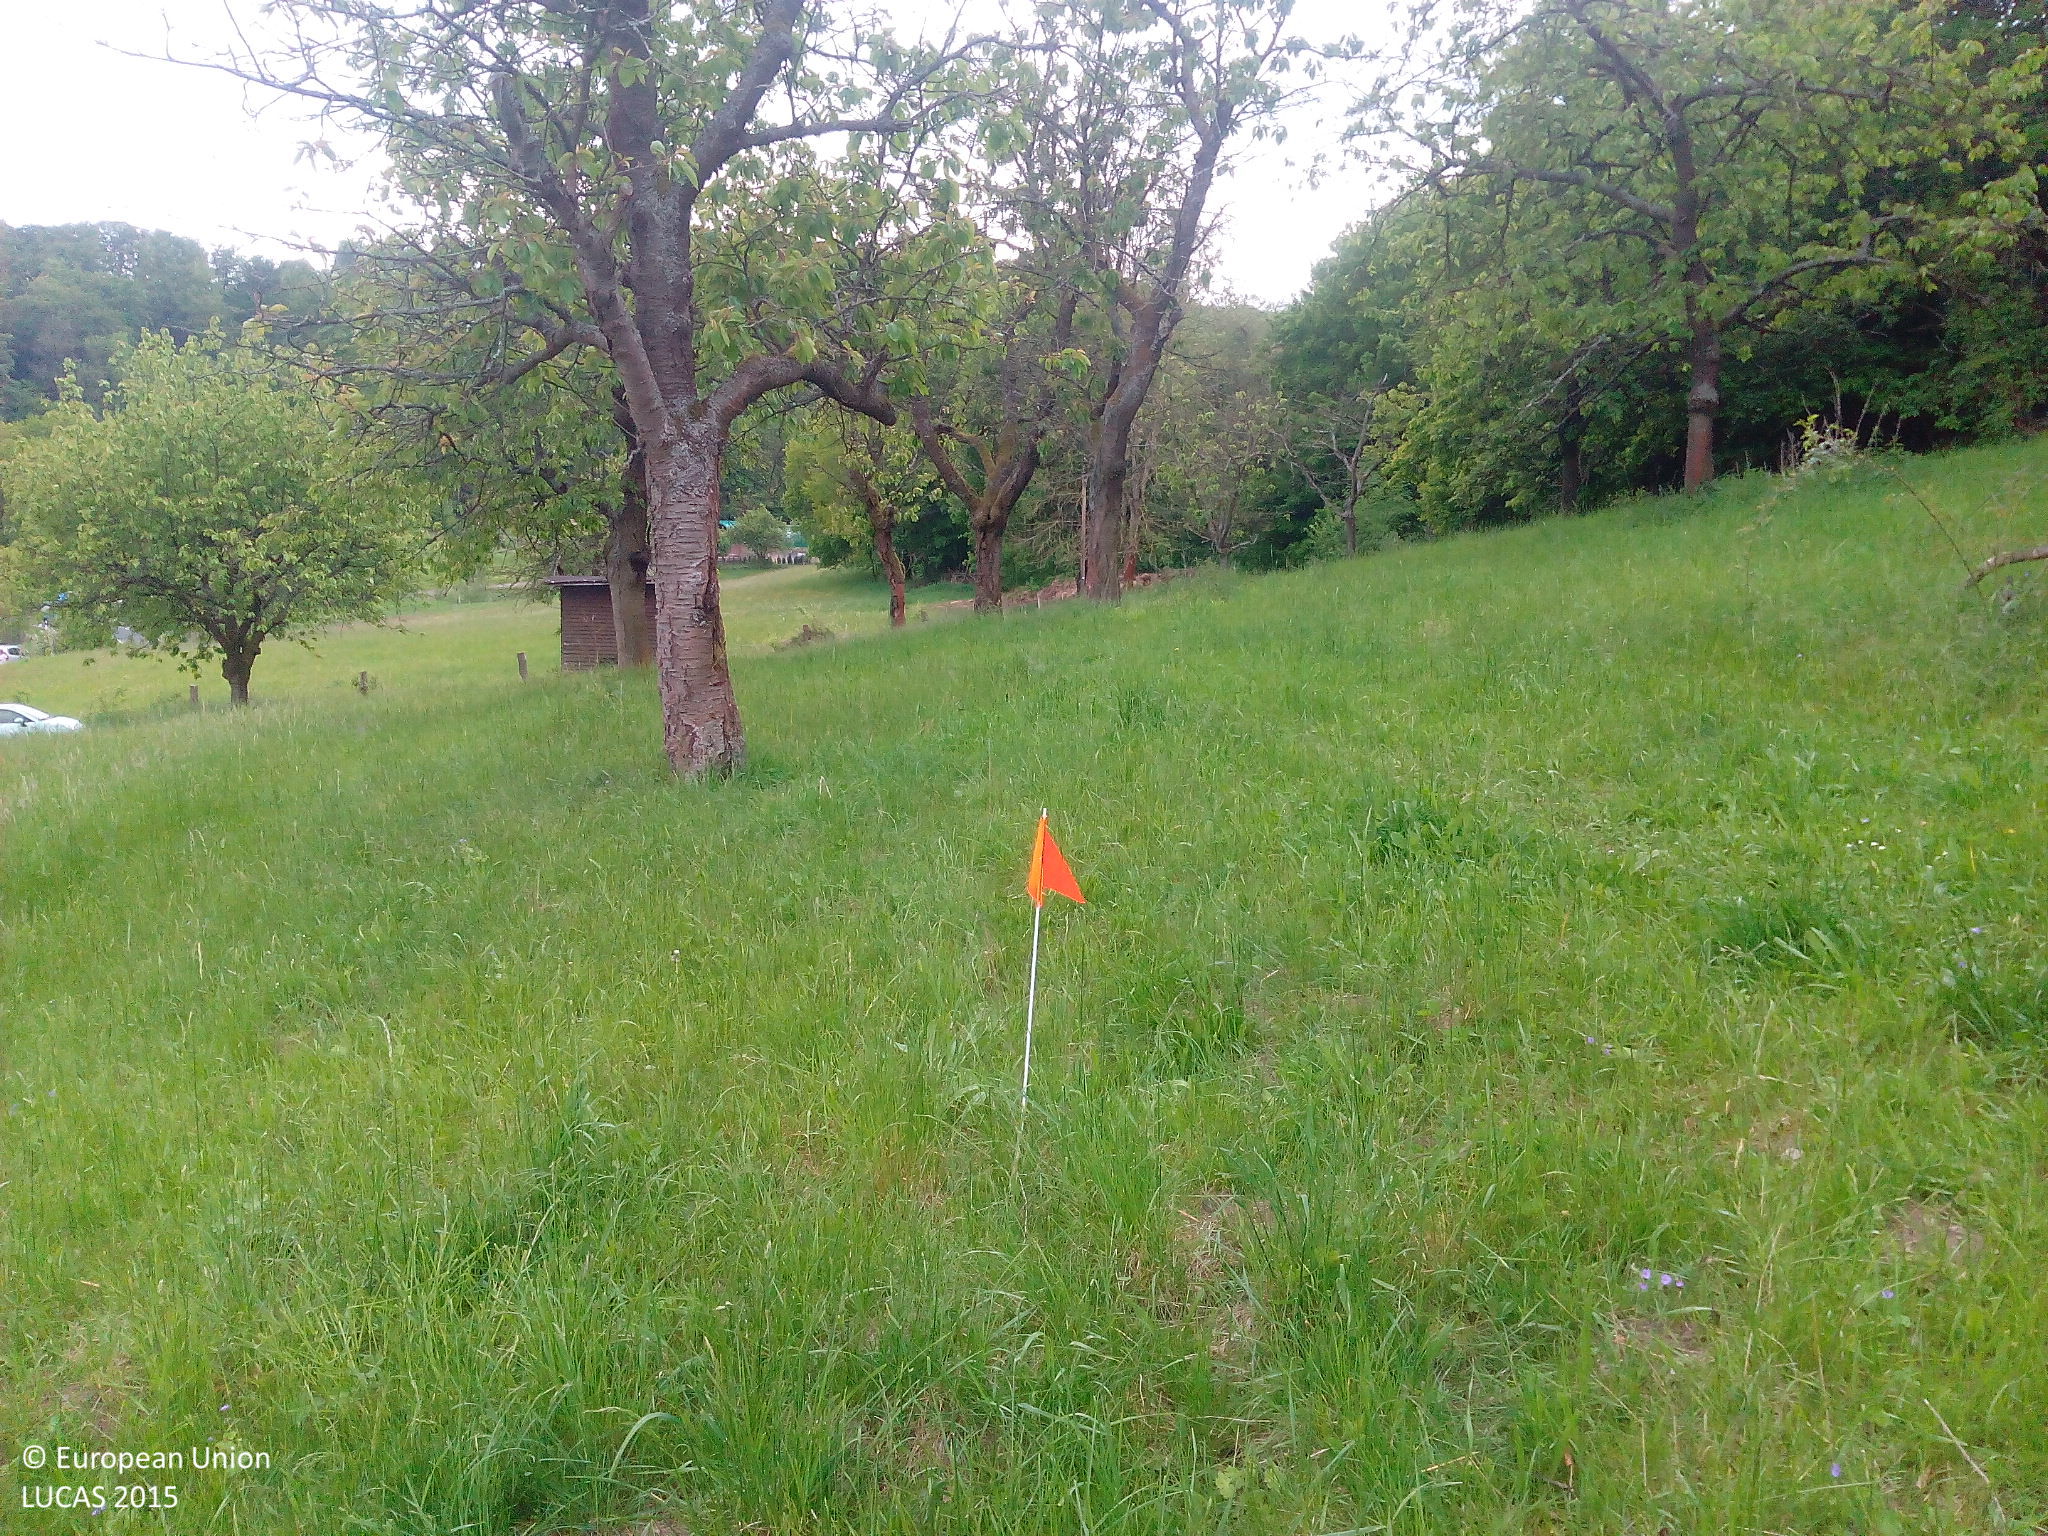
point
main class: Cropland
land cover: Cherry fruit
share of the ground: 25 - 50 %
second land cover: Grassland without tree/shrub cover
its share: > 75 %
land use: Agriculture (excluding fallow land and kitchen gardens)
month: May
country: DE
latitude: 51.2809
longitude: 9.8423
